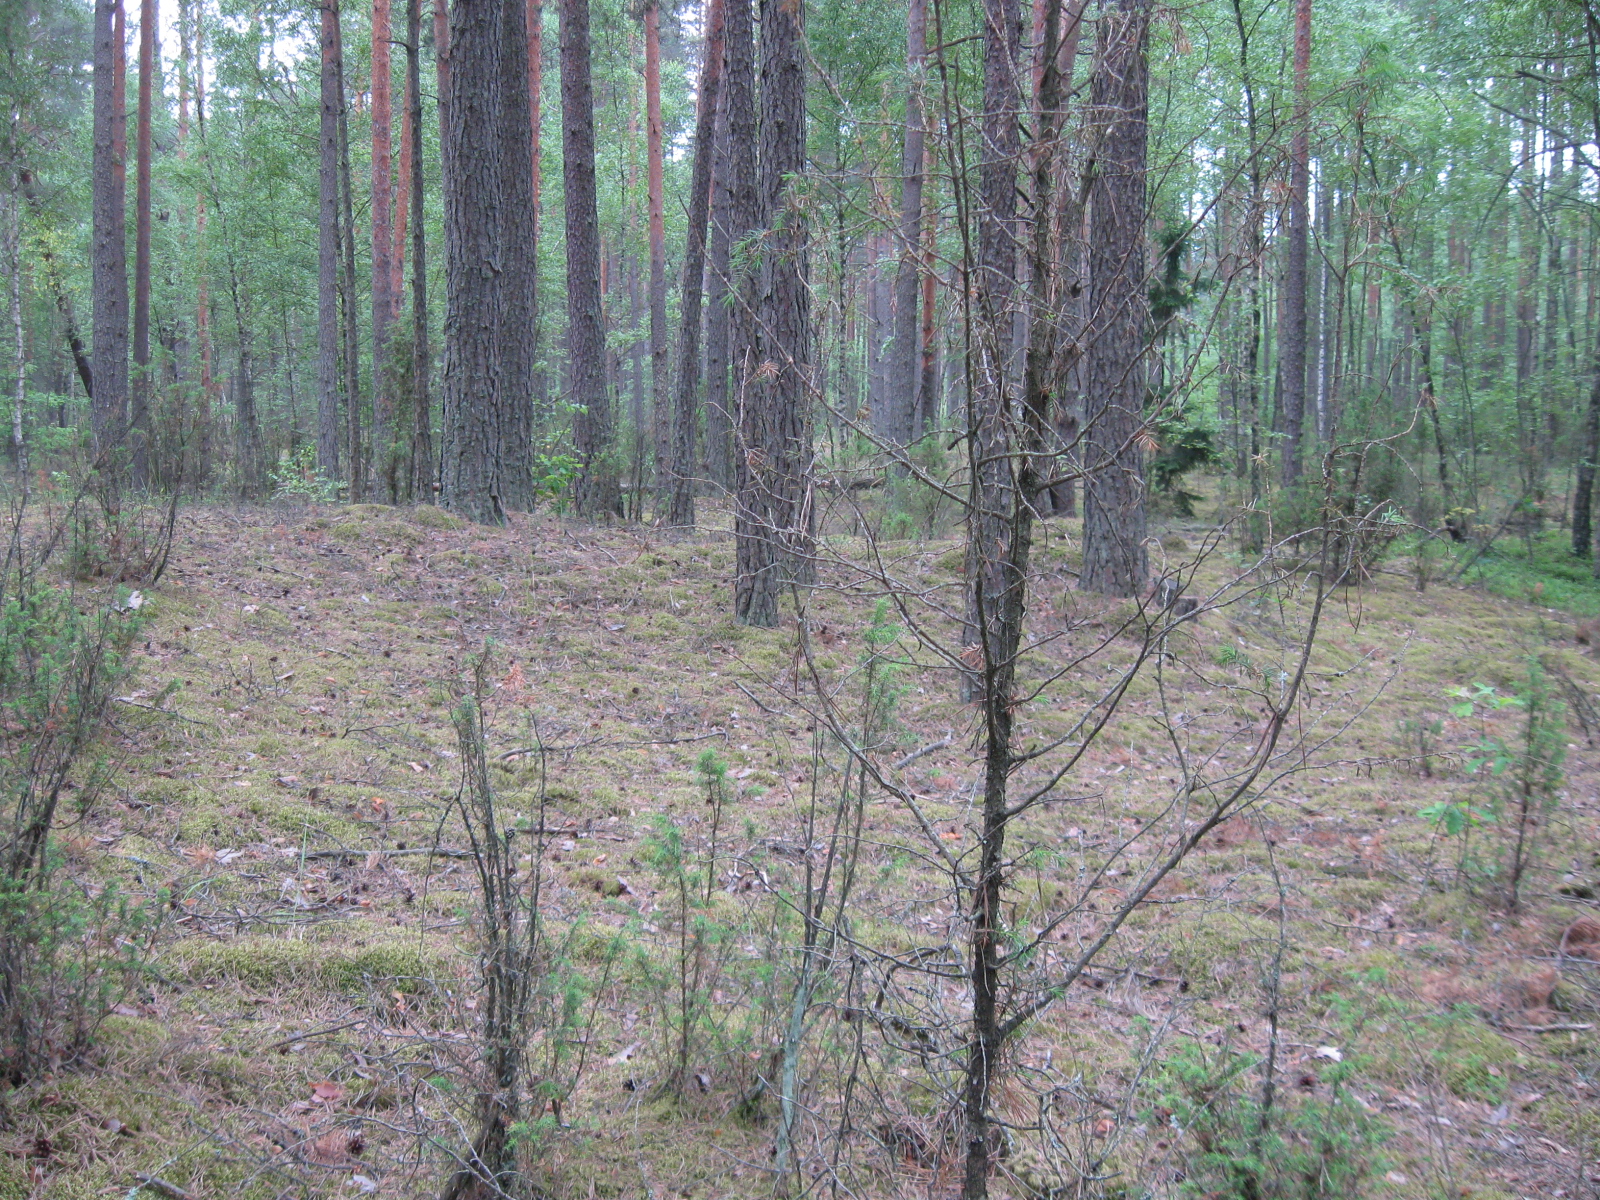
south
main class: Woodland
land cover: Pine dominated coniferous woodland
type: hemiboreal forest and nemoral coniferous forest and mixed broadleaved-coniferous forest
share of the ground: > 75 %
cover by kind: coniferous forest trees 95 %, lichens and mosses 5 %
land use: Forestry
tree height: > 5 m
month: July
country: LT
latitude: 54.1388
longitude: 24.2883
